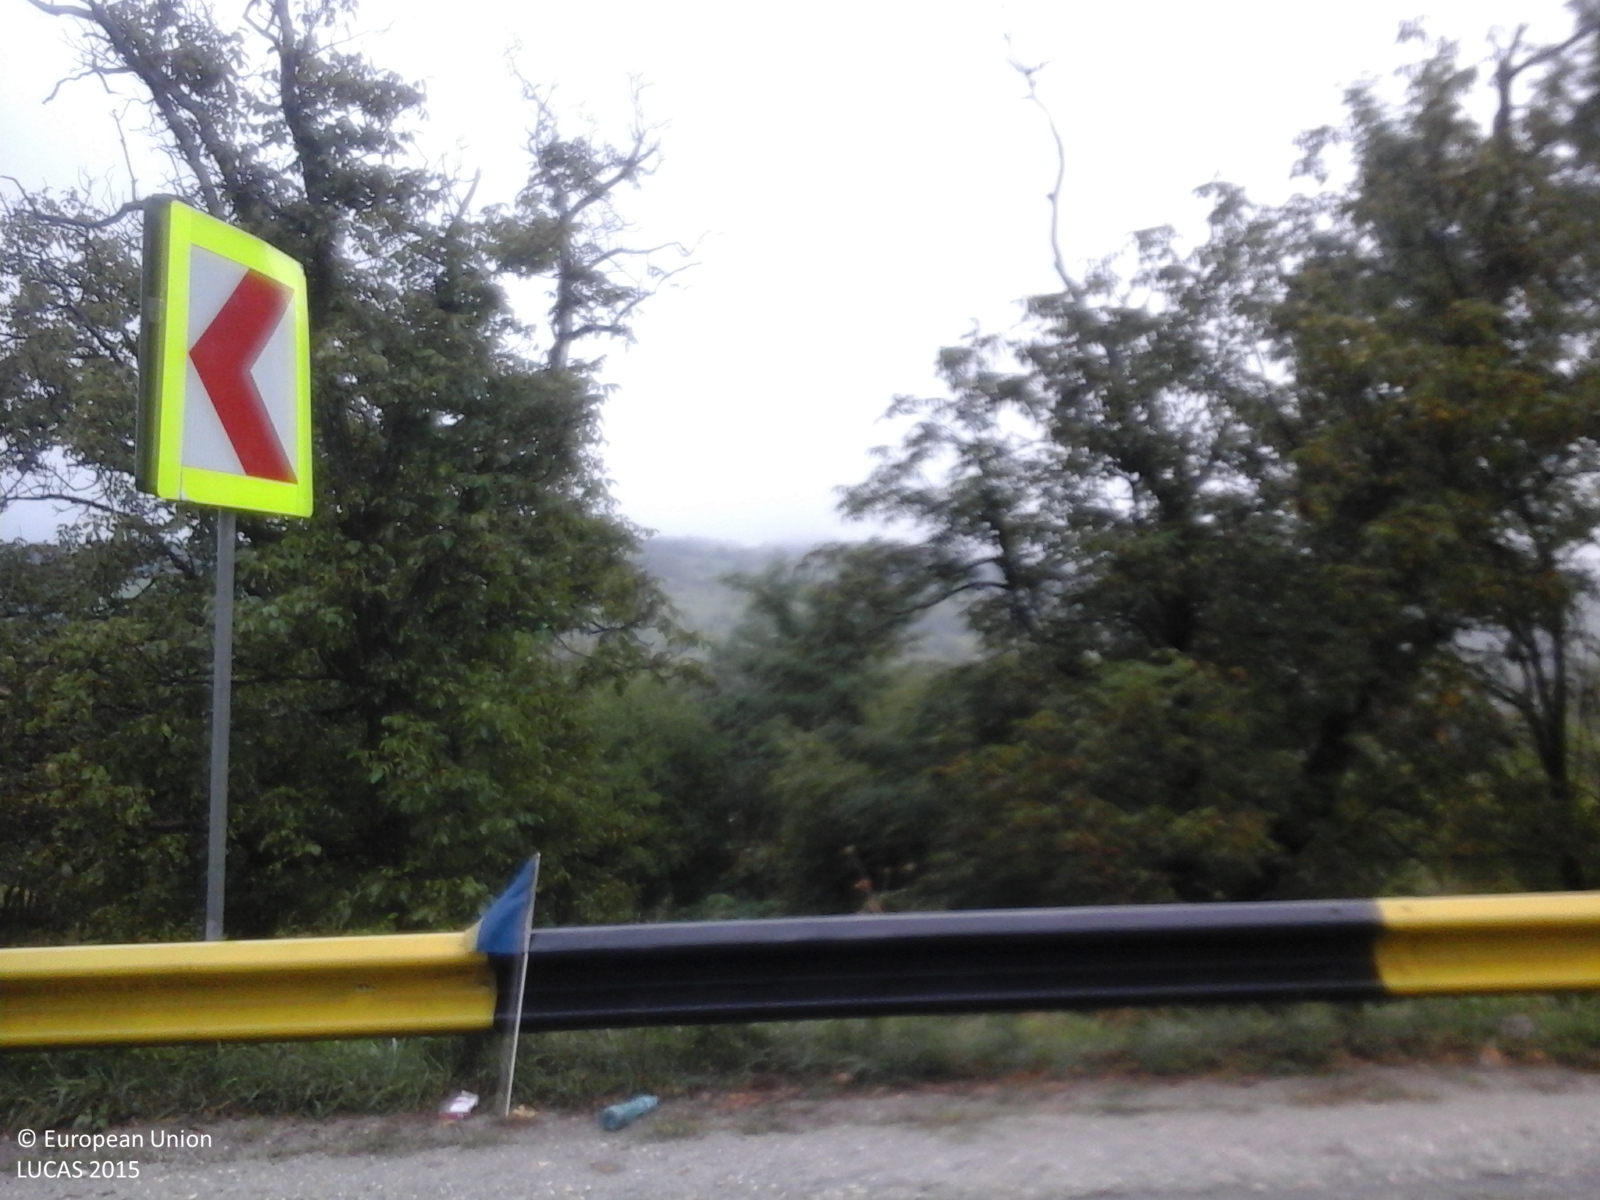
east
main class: Grassland
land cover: Grassland without tree/shrub cover
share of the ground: > 75 %
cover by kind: herbaceous plants 100 %
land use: Agriculture (excluding fallow land and kitchen gardens)
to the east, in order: Grassland without tree/shrub cover; Nuts trees; Fences; Grassland without tree/shrub cover; Fences; Grassland without tree/shrub cover; Permanent crops (only in case pi); Fences; Permanent crops (only in case pi)
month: September
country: RO
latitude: 45.1430
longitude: 23.7855
